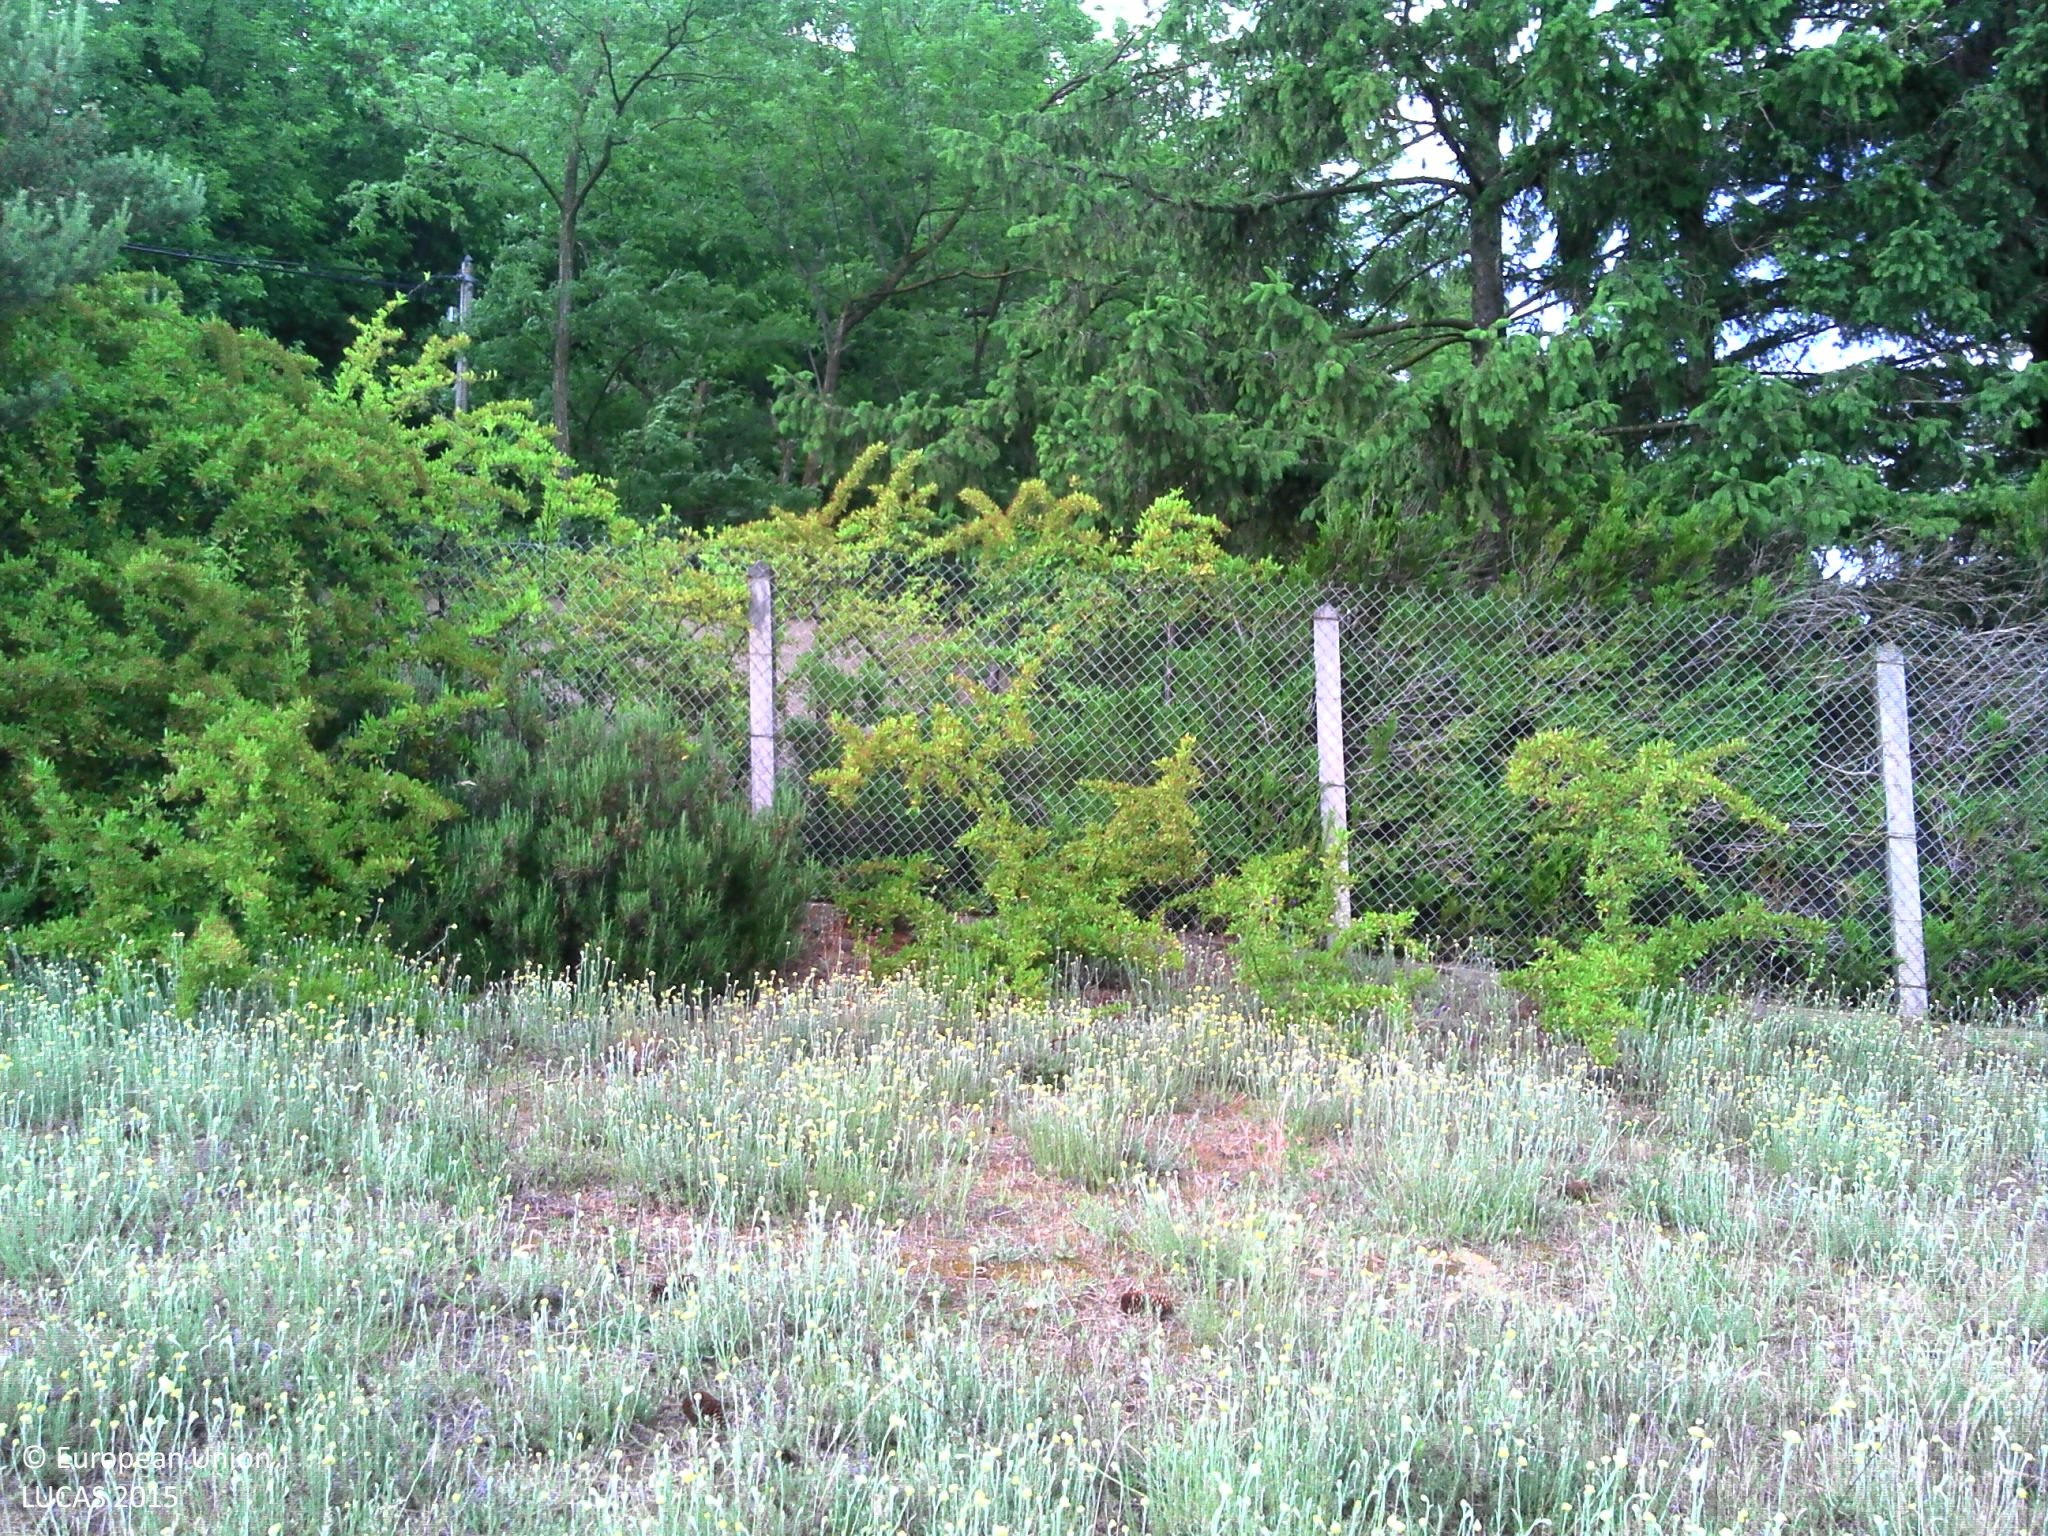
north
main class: Grassland
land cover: Grassland without tree/shrub cover
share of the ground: > 75 %
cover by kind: herbaceous plants 100 %
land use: Agriculture (excluding fallow land and kitchen gardens)
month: May
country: FR
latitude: 45.0988
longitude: 5.0367
